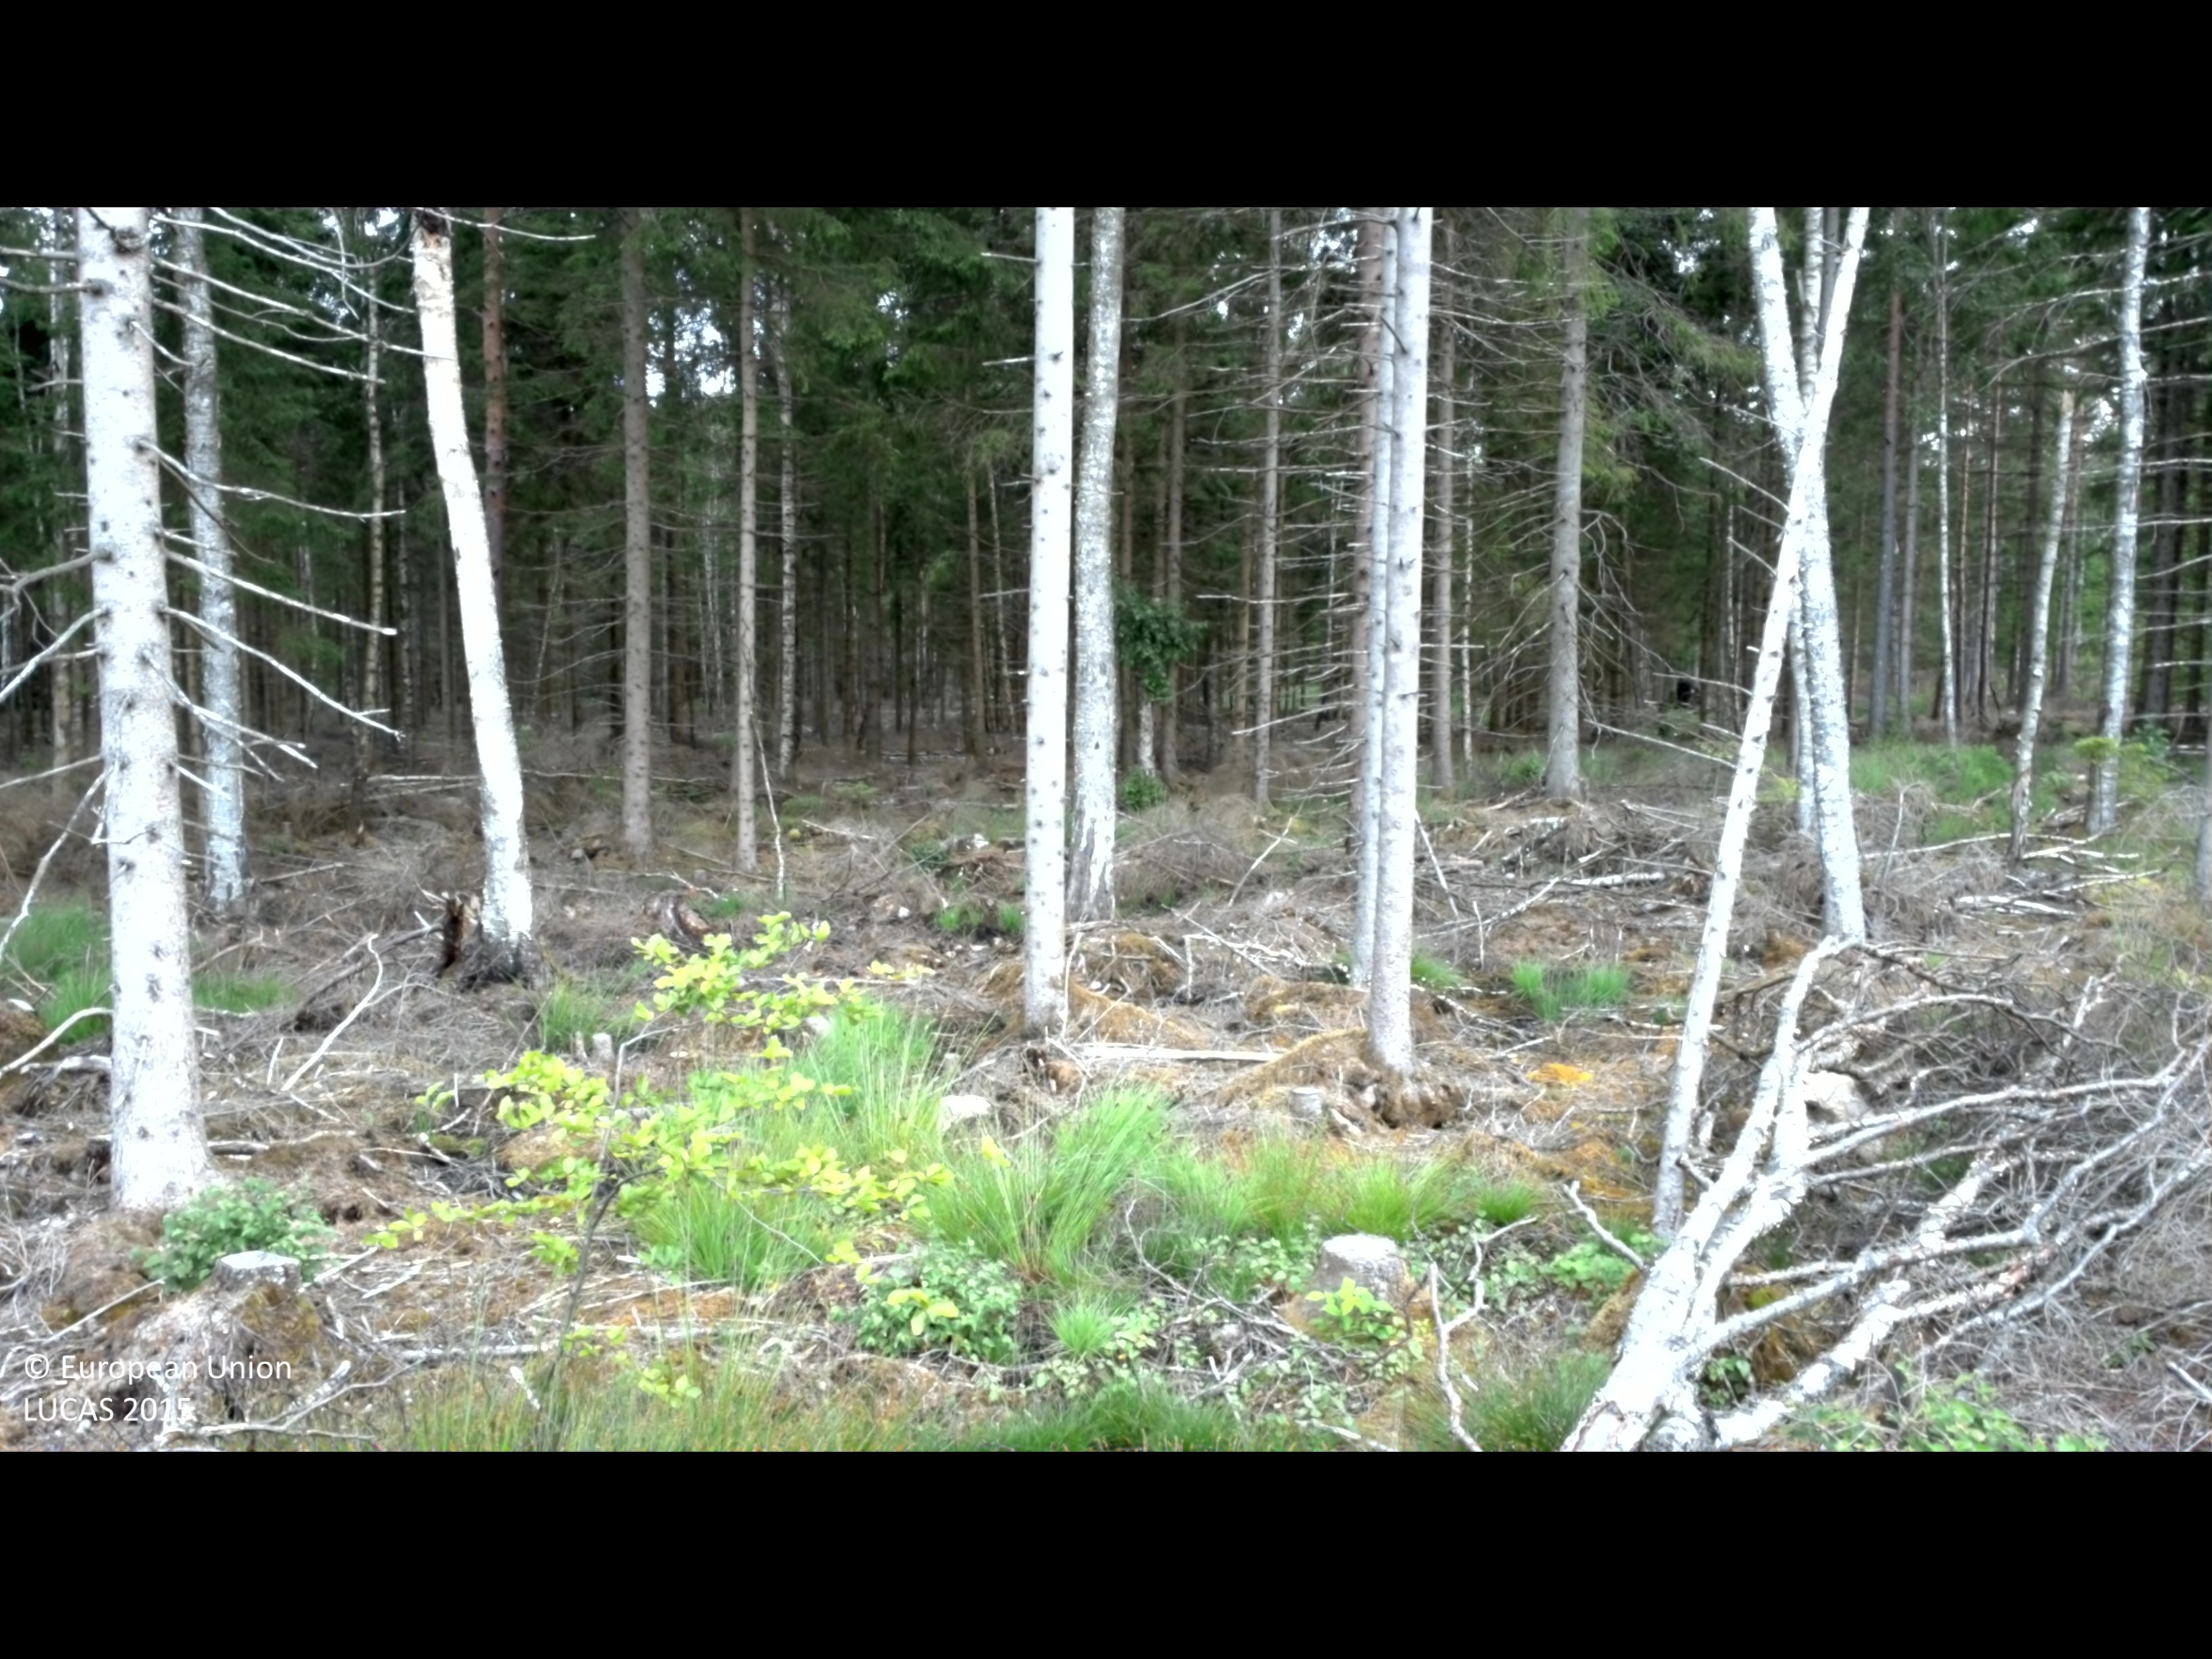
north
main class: Woodland
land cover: Spruce dominated mixed woodland
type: boreal forest
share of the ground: 10 - 25 %
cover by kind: shrubs 20 %, coniferous forest trees 15 %, herbaceous plants 15 %, unconsolidated bare surface 10 %, broadleaved forest trees 5 %, lichens and mosses 5 %
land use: Forestry
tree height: > 5 m
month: July
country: SE
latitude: 56.4453
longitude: 14.1339
